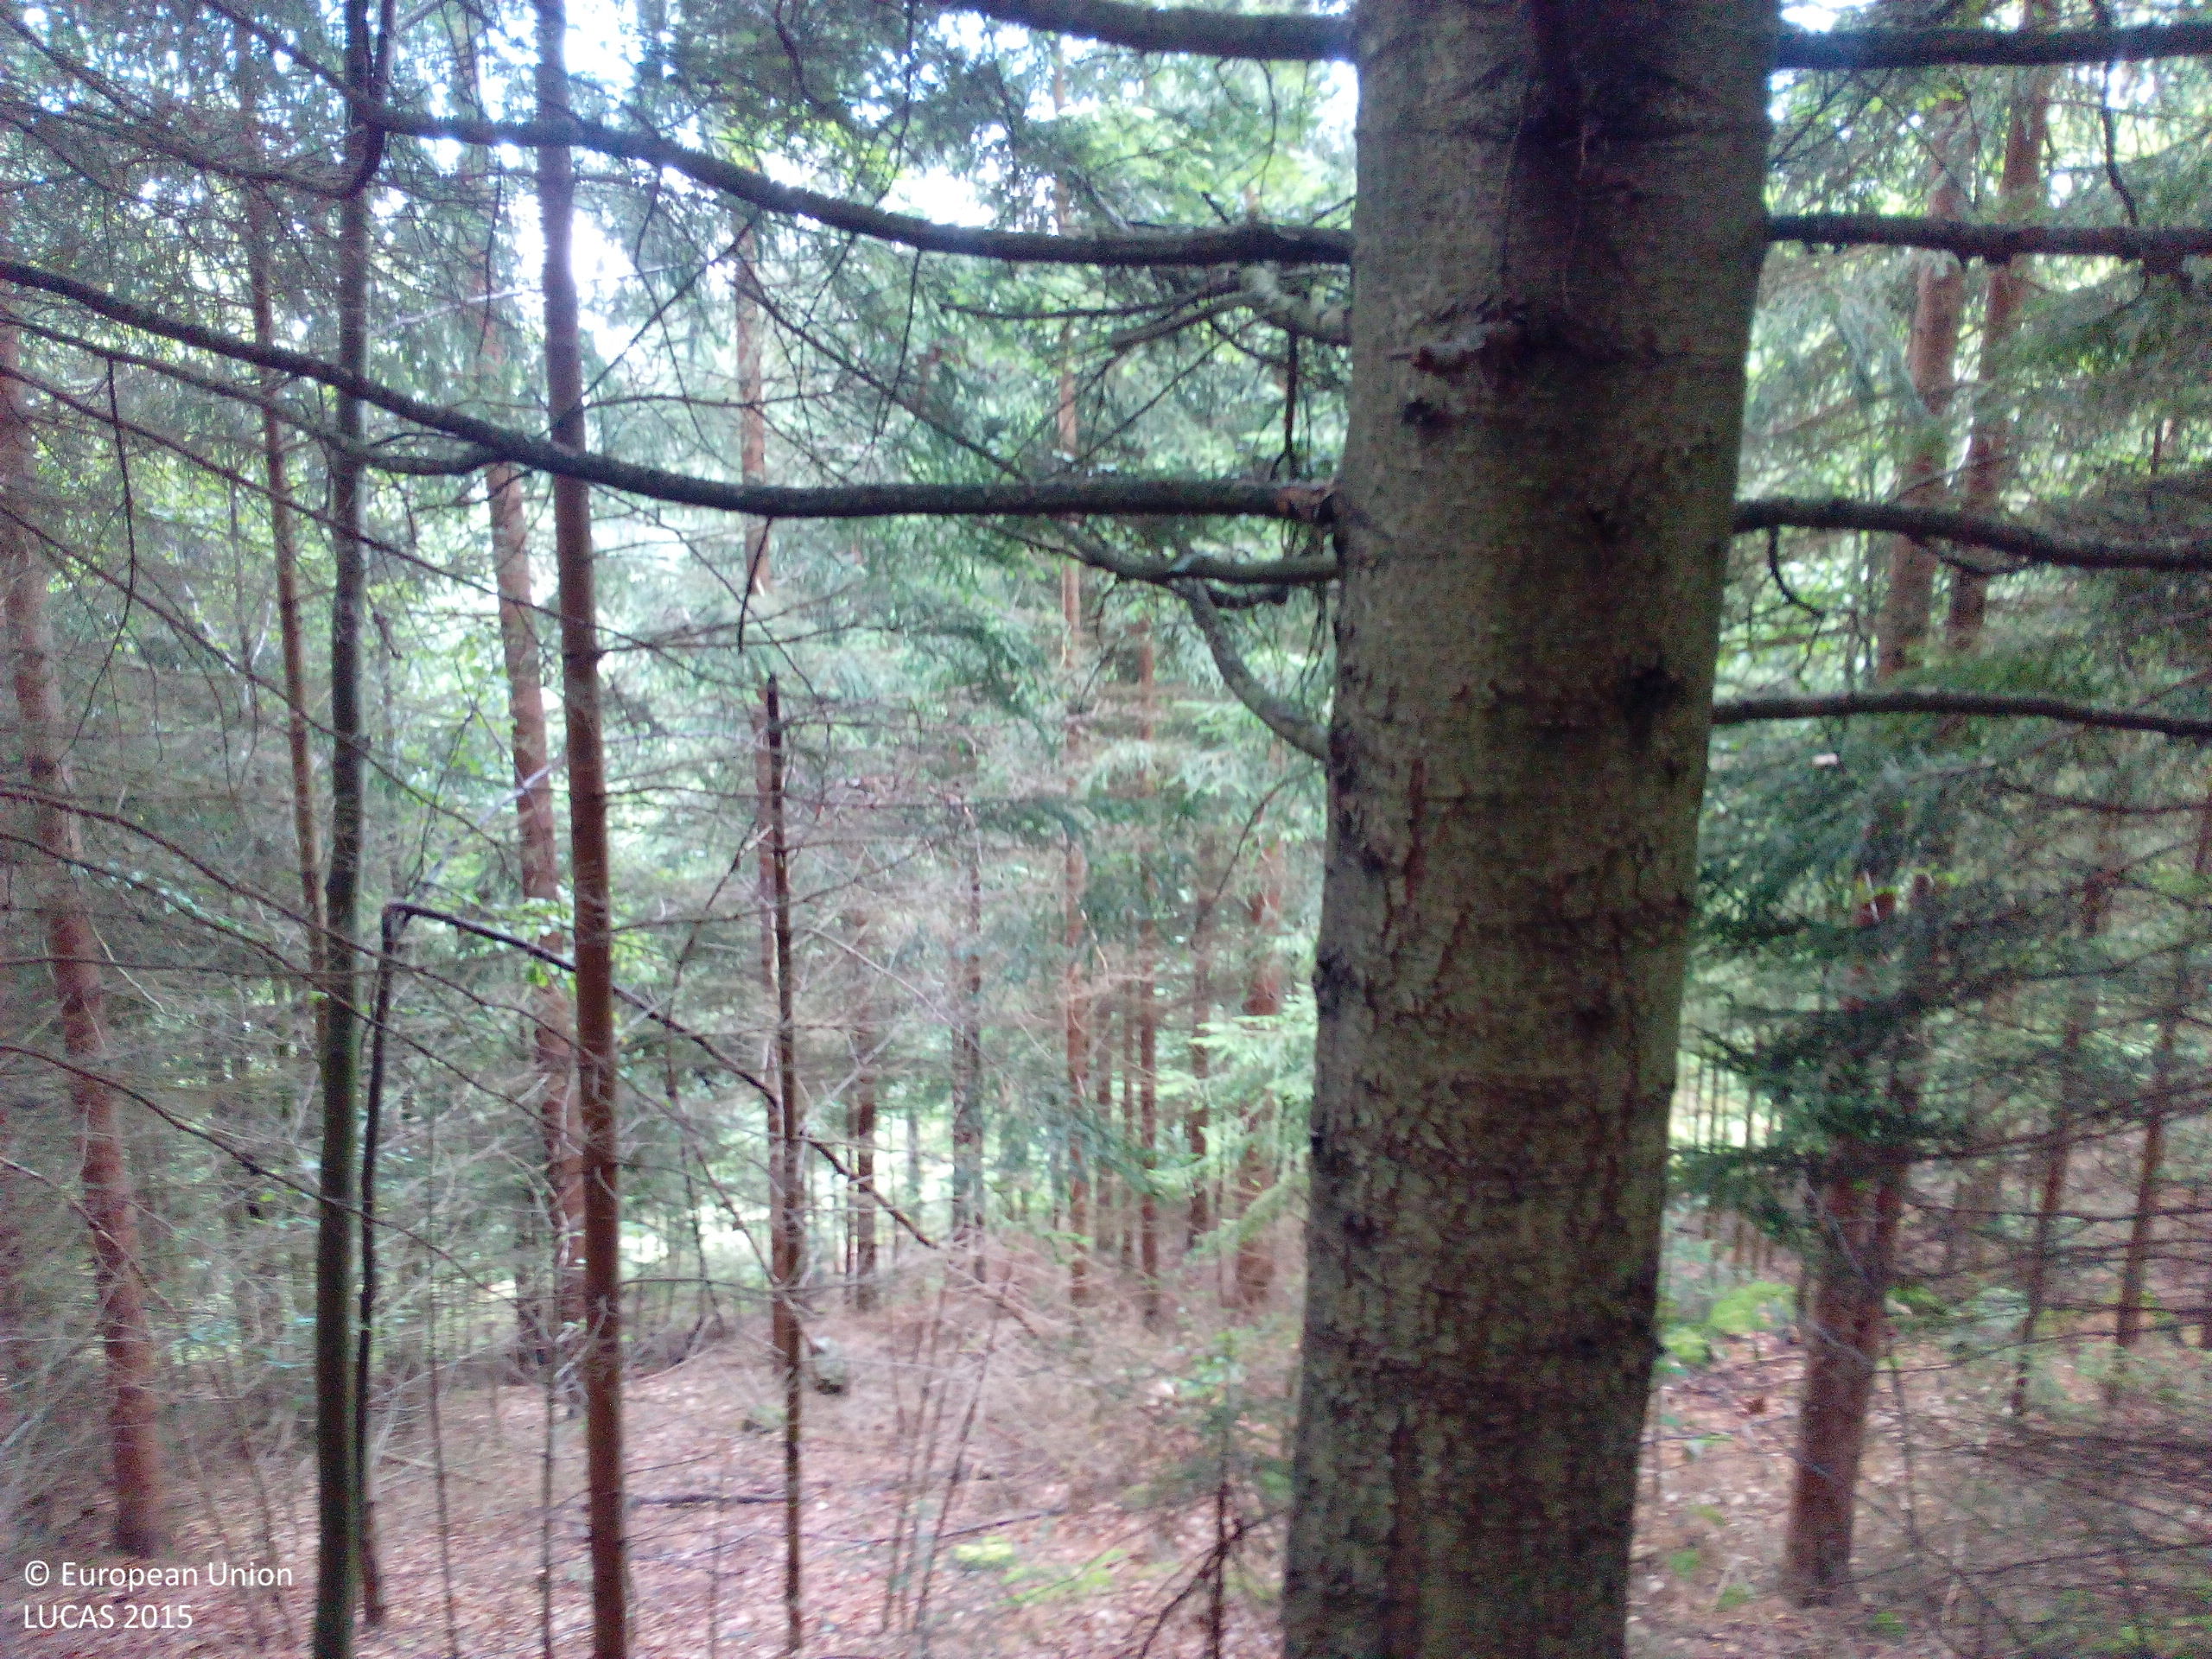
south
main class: Woodland
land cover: Spruce dominated mixed woodland
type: hemiboreal forest and nemoral coniferous forest and mixed broadleaved-coniferous forest
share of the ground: > 75 %
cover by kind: coniferous forest trees 60 %, broadleaved forest trees 25 %, unconsolidated bare surface 10 %, lichens and mosses 5 %
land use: Forestry
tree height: > 5 m
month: July
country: DE
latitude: 49.1556
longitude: 12.9751
